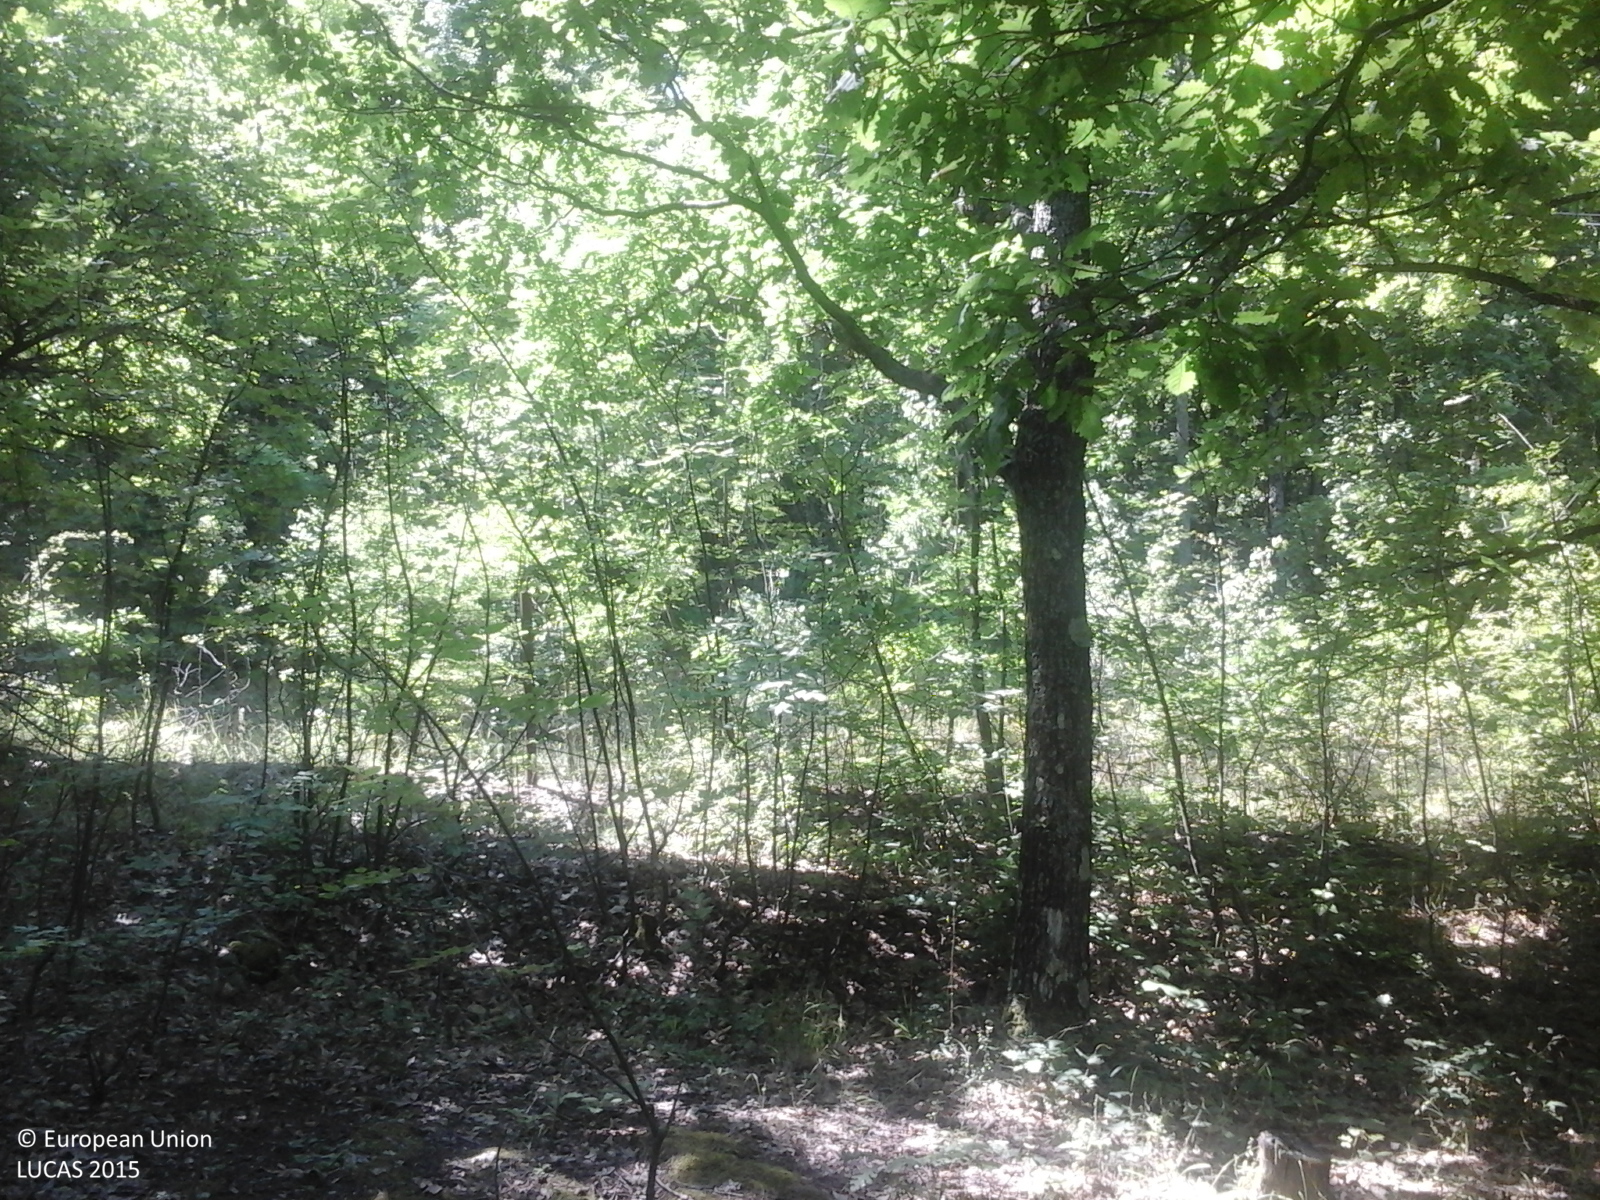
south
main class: Woodland
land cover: Broadleaved woodland
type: mesophytic deciduous forest
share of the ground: > 75 %
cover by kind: broadleaved forest trees 95 %, herbaceous plants 5 %
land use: Forestry
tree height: > 5 m
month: July
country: RO
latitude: 44.6806
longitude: 24.3640
